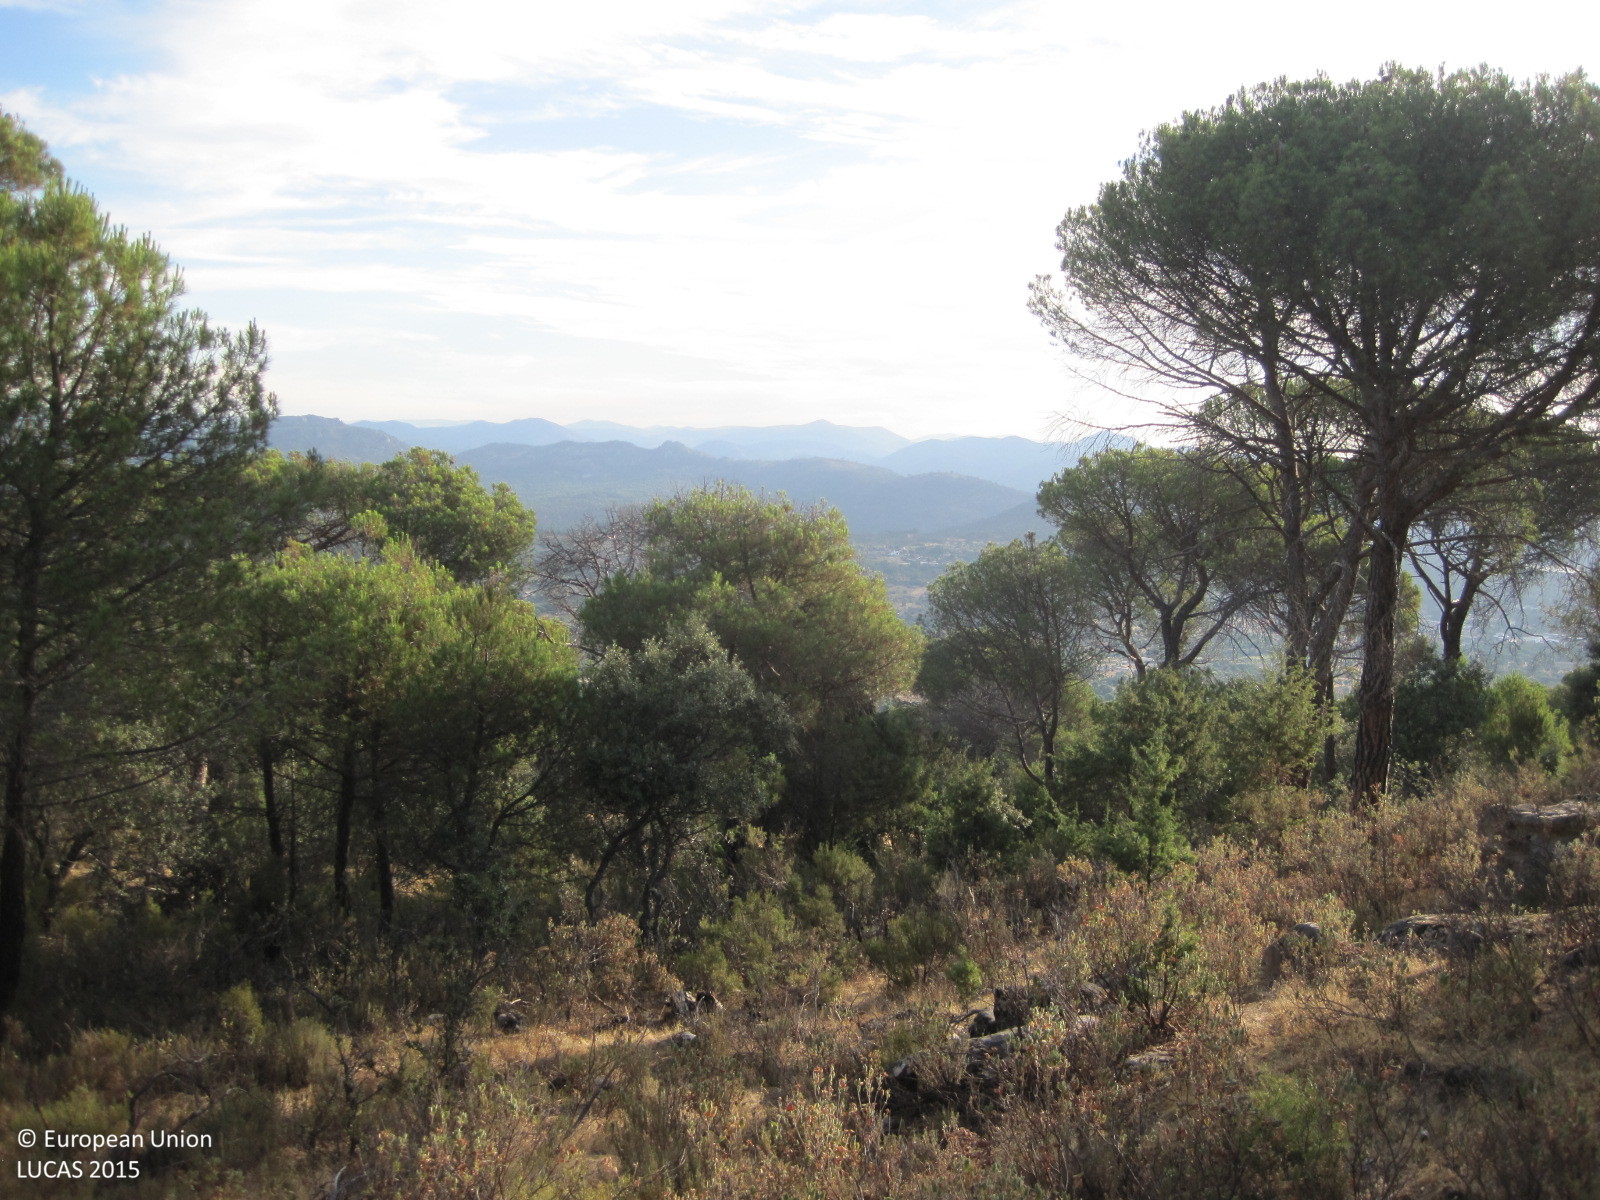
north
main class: Woodland
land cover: Pine dominated mixed woodland
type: coniferous forest of the mediterranean region
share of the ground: > 75 %
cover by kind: coniferous forest trees 50 %, broadleaved forest trees 25 %, shrubs 10 %, herbaceous plants 10 %, unconsolidated bare surface 5 %
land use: Semi-natural and natural areas not in use
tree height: > 5 m
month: July
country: ES
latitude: 40.3401
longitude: -4.3724
